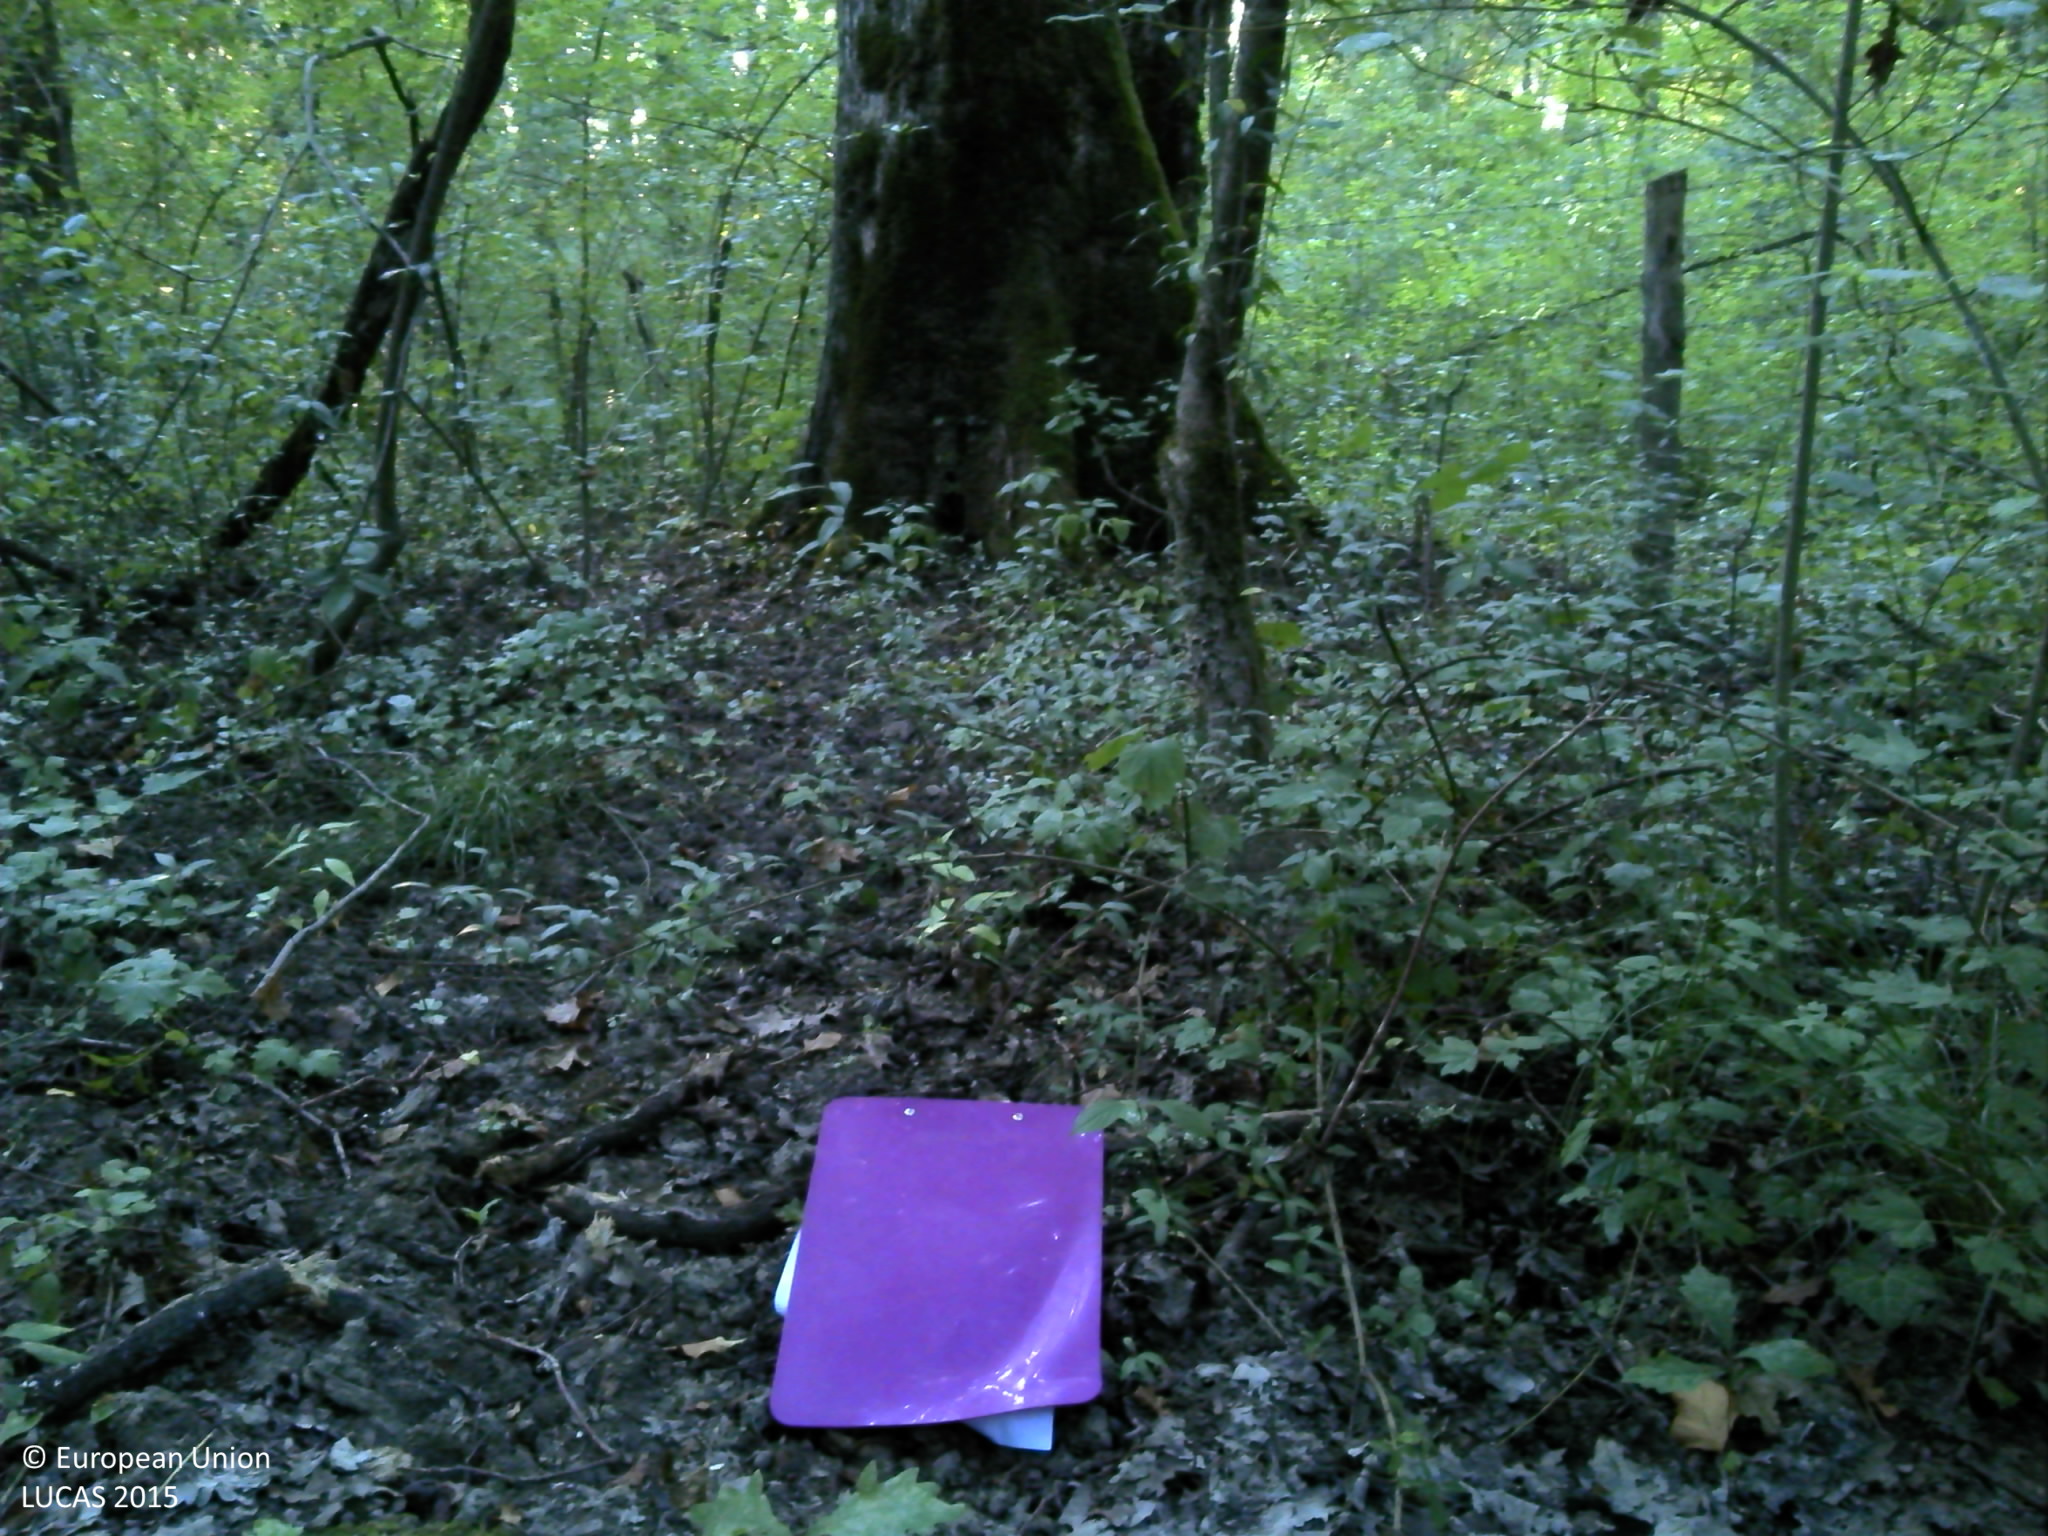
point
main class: Woodland
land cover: Broadleaved woodland
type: acidophilous oak and oak-birch forest
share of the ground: > 75 %
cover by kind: broadleaved forest trees 100 %
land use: Forestry
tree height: > 5 m
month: August
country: HR
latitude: 45.5247
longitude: 16.4381
